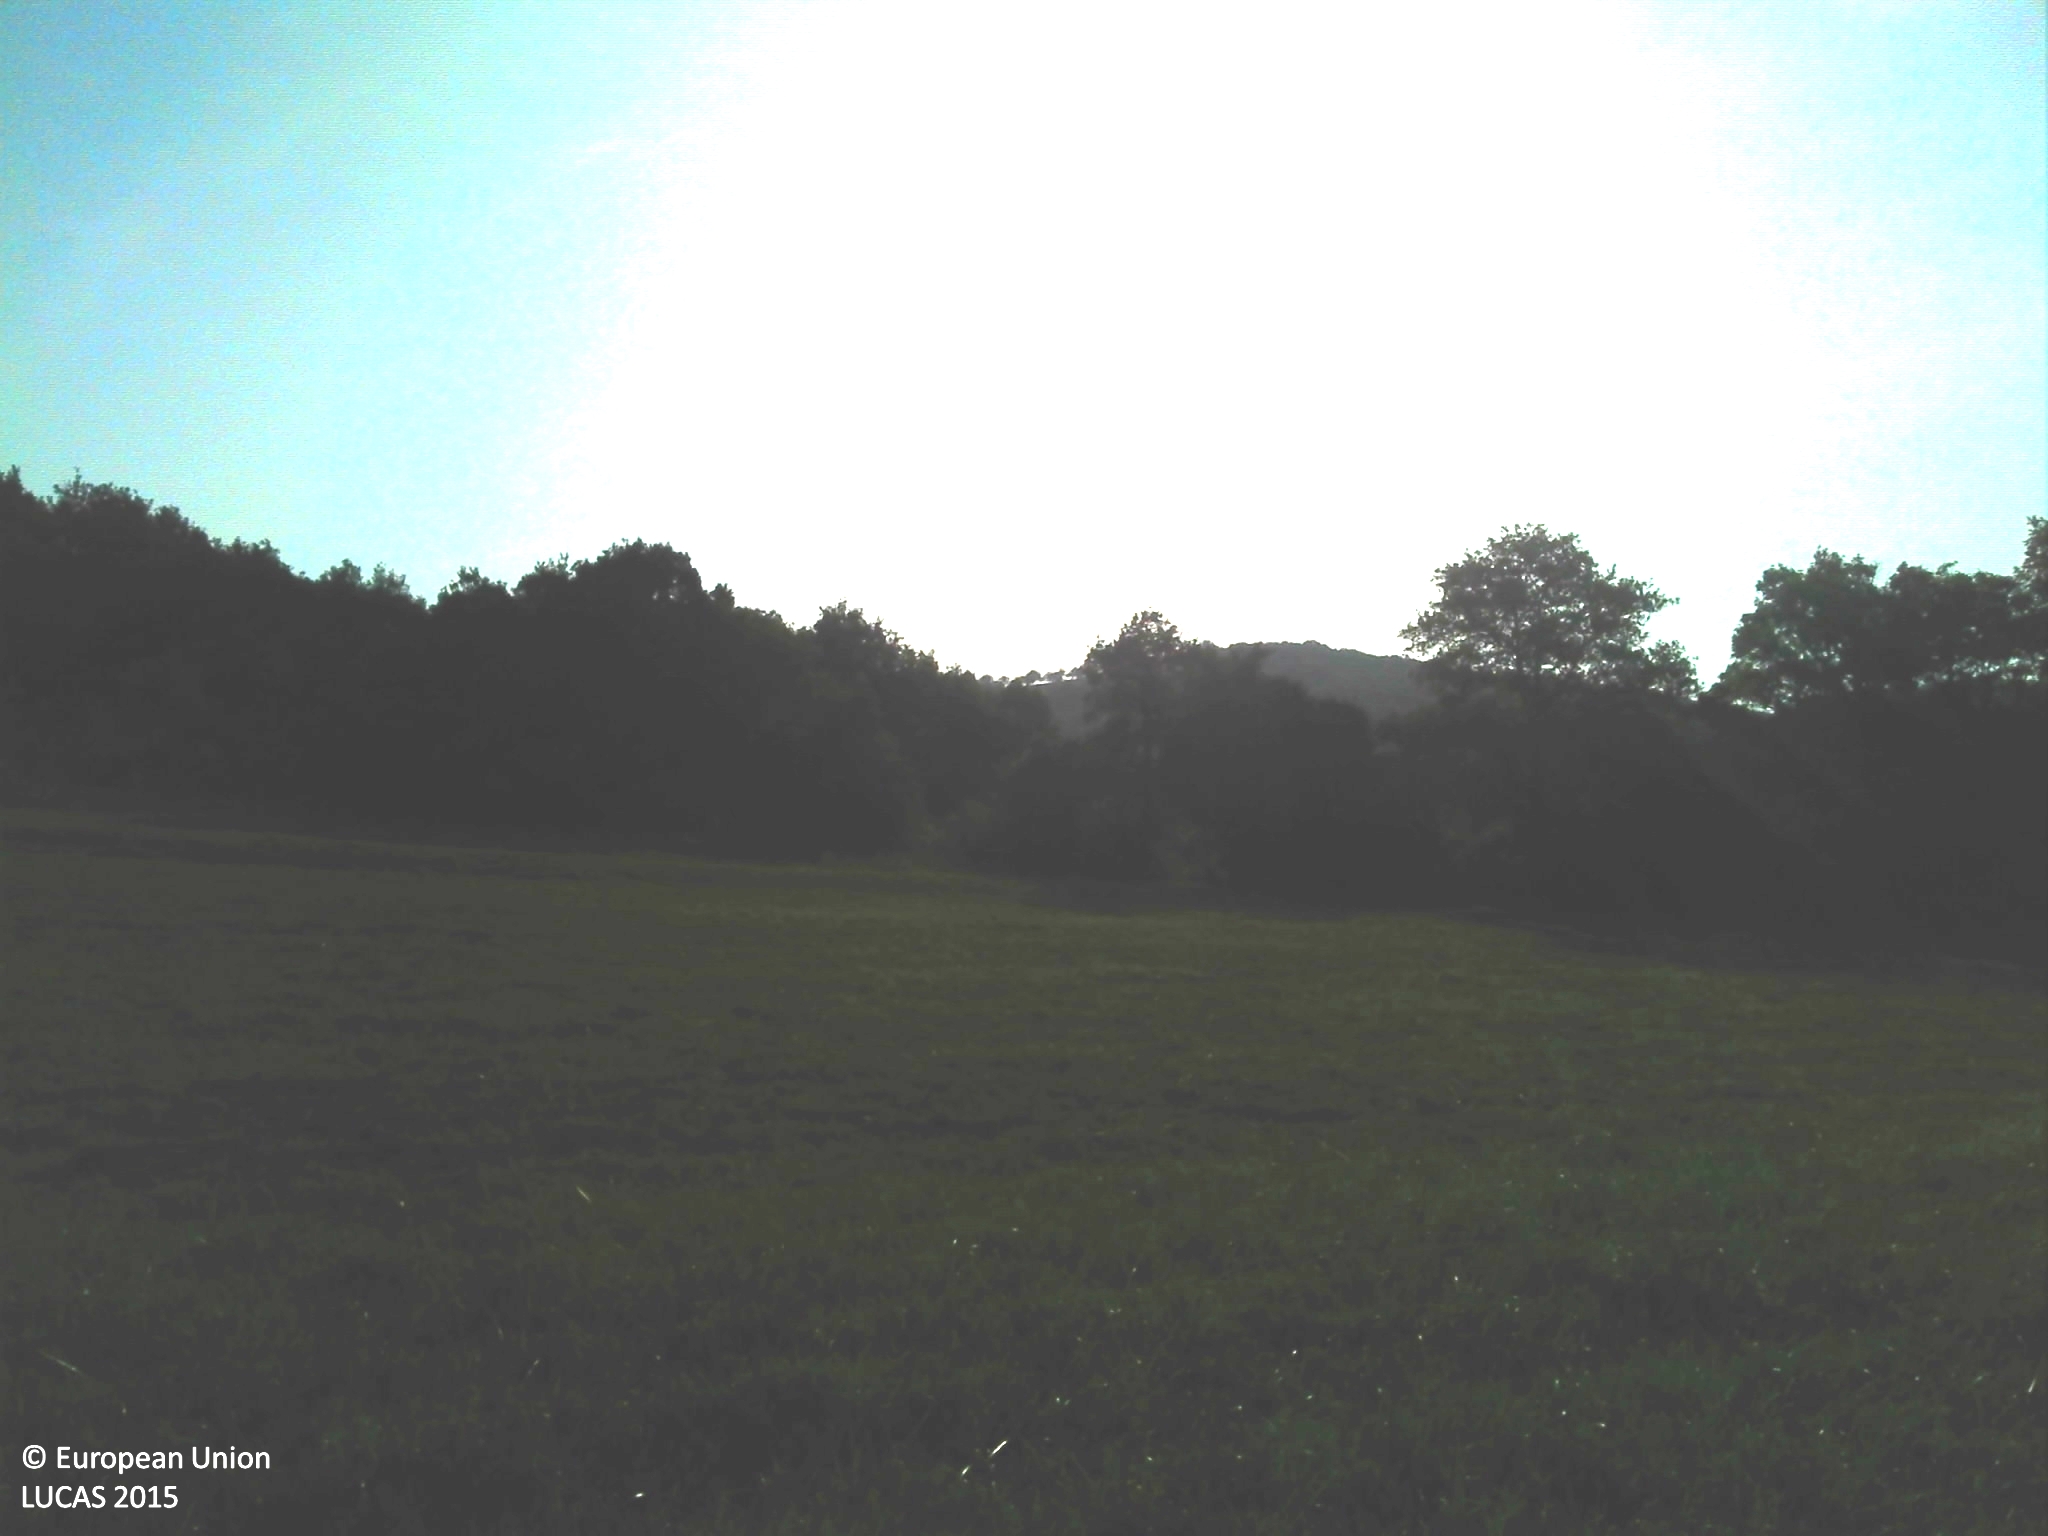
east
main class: Grassland
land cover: Grassland without tree/shrub cover
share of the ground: > 75 %
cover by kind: herbaceous plants 100 %
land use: Agriculture (excluding fallow land and kitchen gardens)
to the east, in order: Grassland without tree/shrub cover; Broadleaved woodland; Fences; Grassland without tree/shrub cover; Abandoned hedges; Ditches and canals; Fences; Grassland without tree/shrub cover; Broadleaved woodland; Grassland without tree/shrub cover
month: July
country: FR
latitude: 43.1300
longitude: 1.0667
